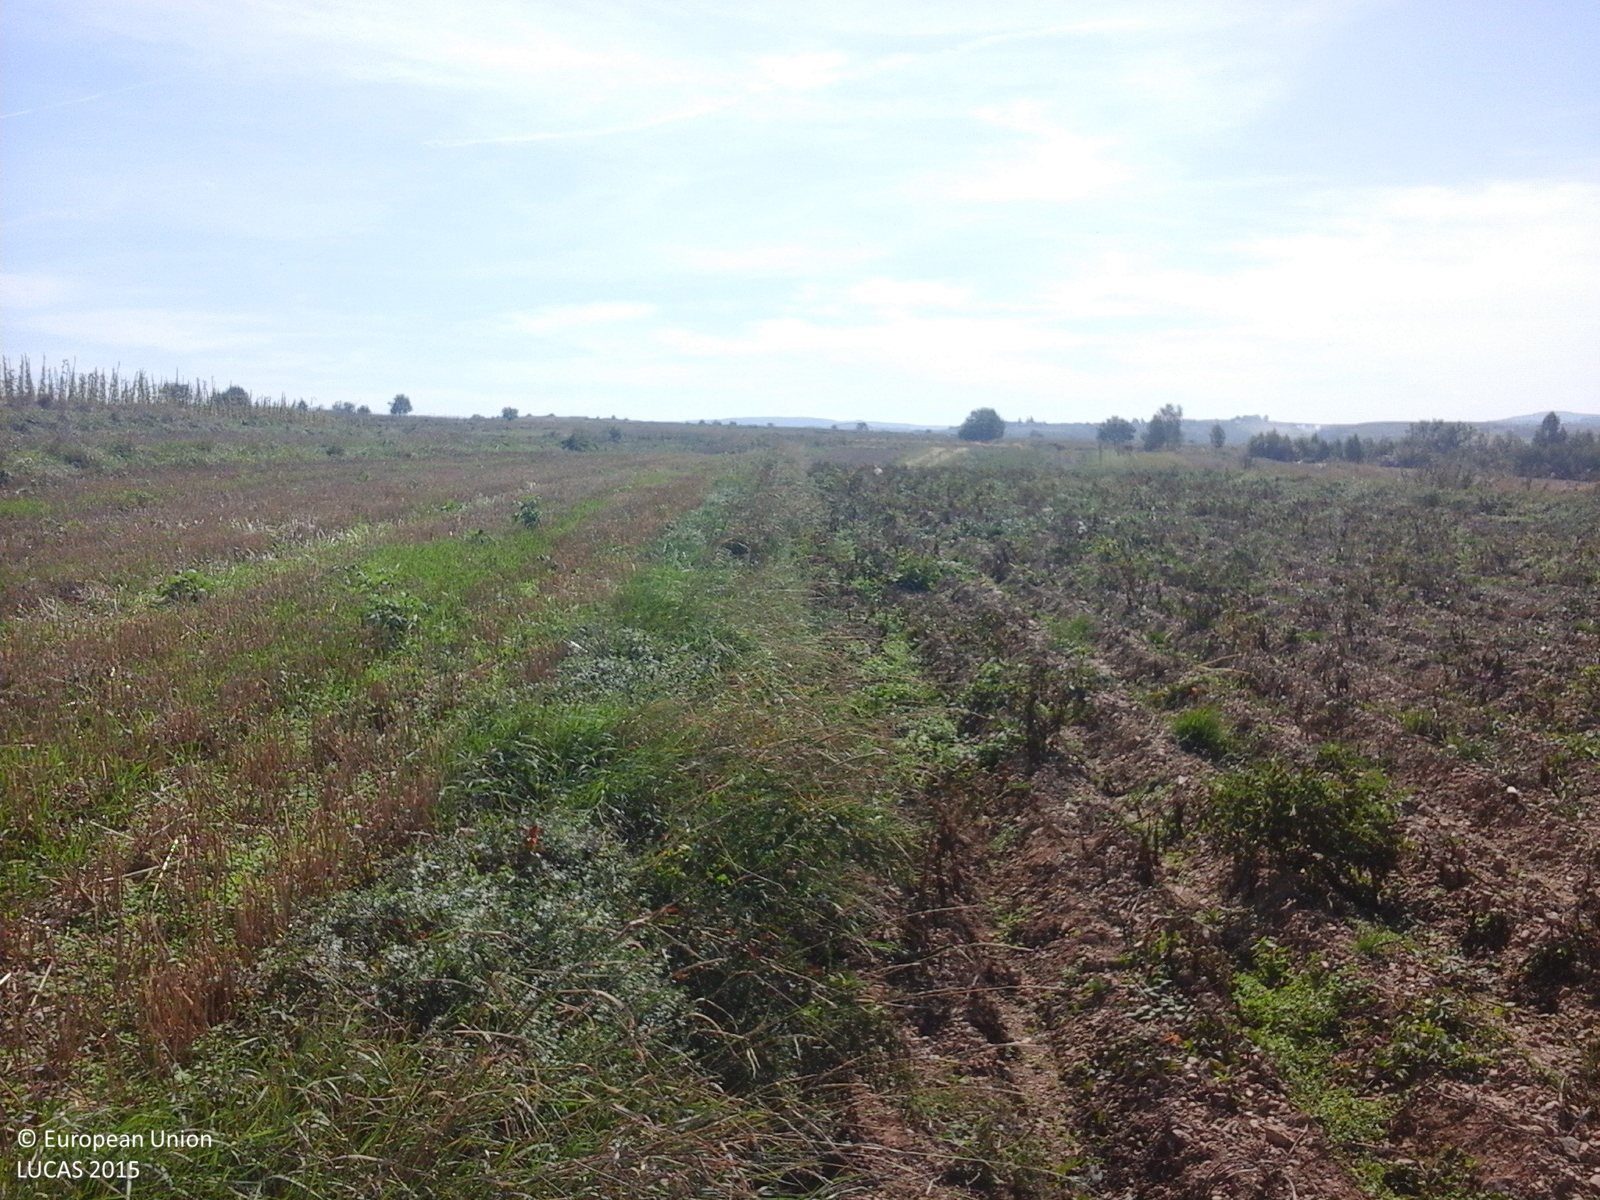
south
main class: Cropland
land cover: Potatoes
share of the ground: > 75 %
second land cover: Spontaneously vegetated surfaces
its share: 25 - 50 %
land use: Agriculture (excluding fallow land and kitchen gardens)
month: September
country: RO
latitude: 46.7516
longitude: 23.1940
